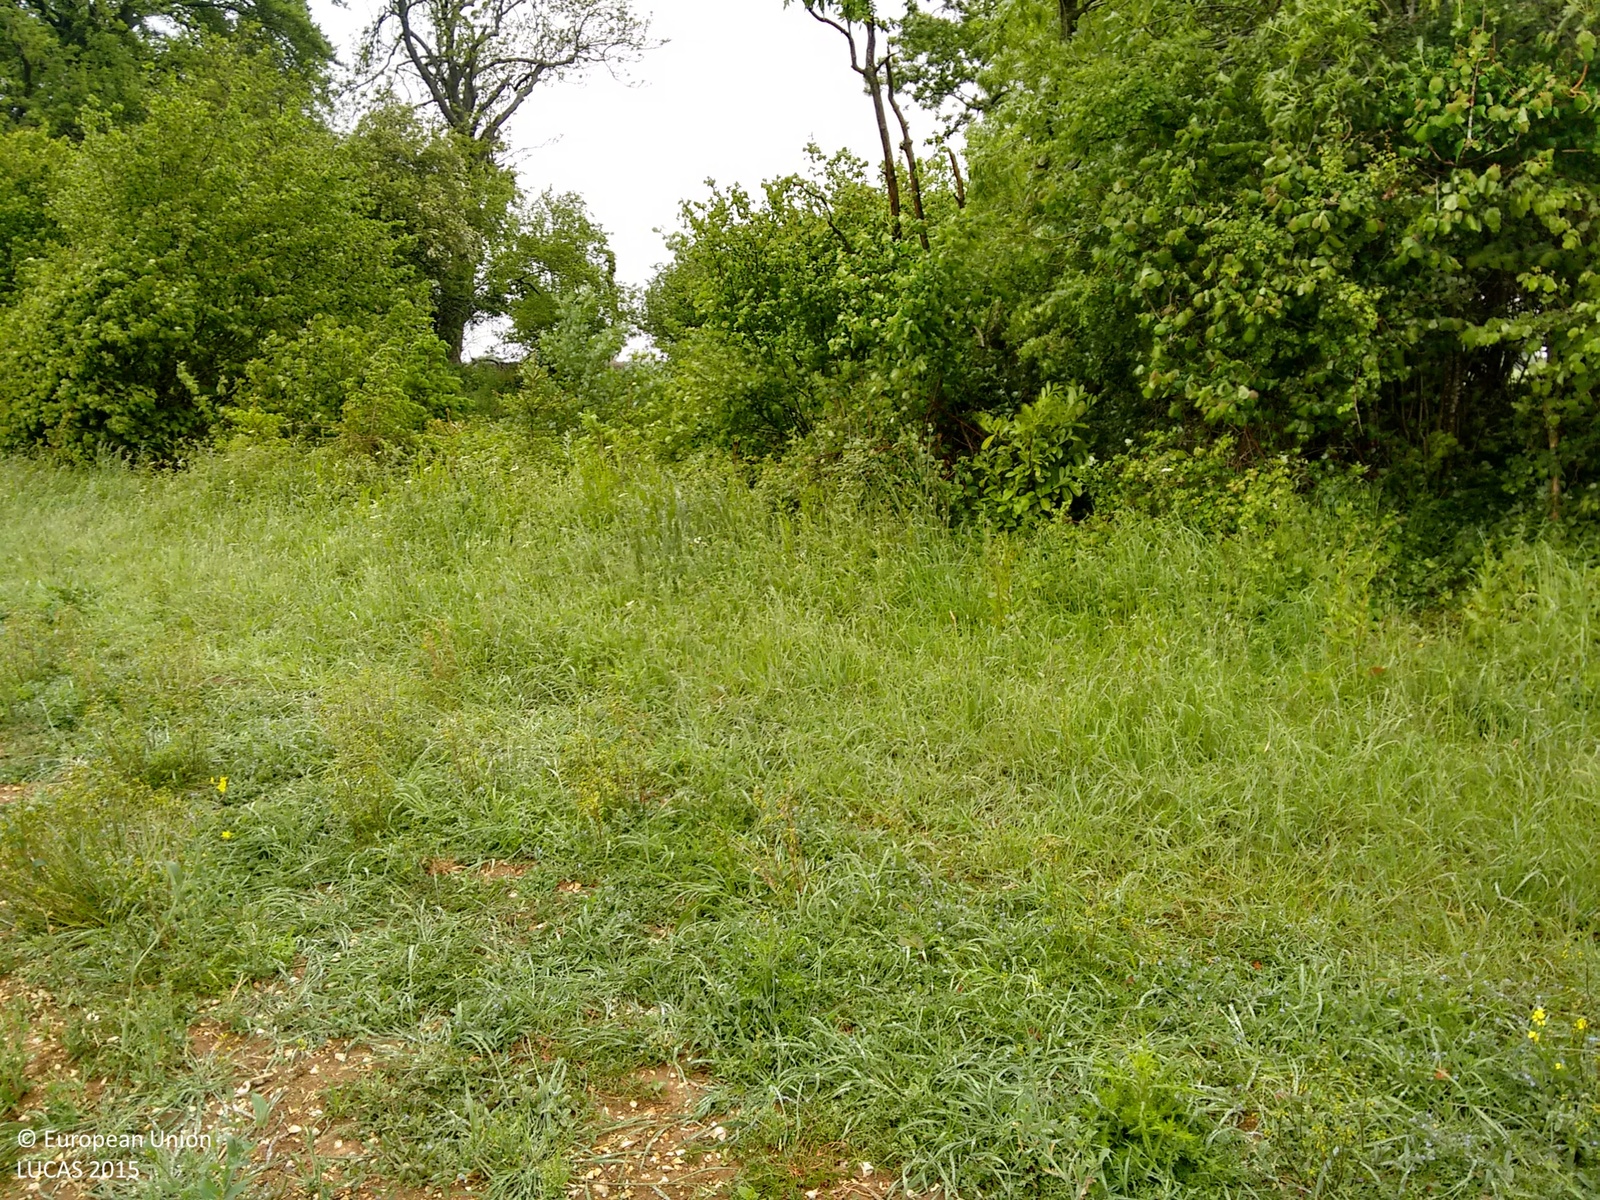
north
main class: Cropland
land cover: Rape and turnip rape
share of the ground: > 75 %
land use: Agriculture (excluding fallow land and kitchen gardens)
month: June
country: GB
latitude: 51.1271
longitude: -1.1199
